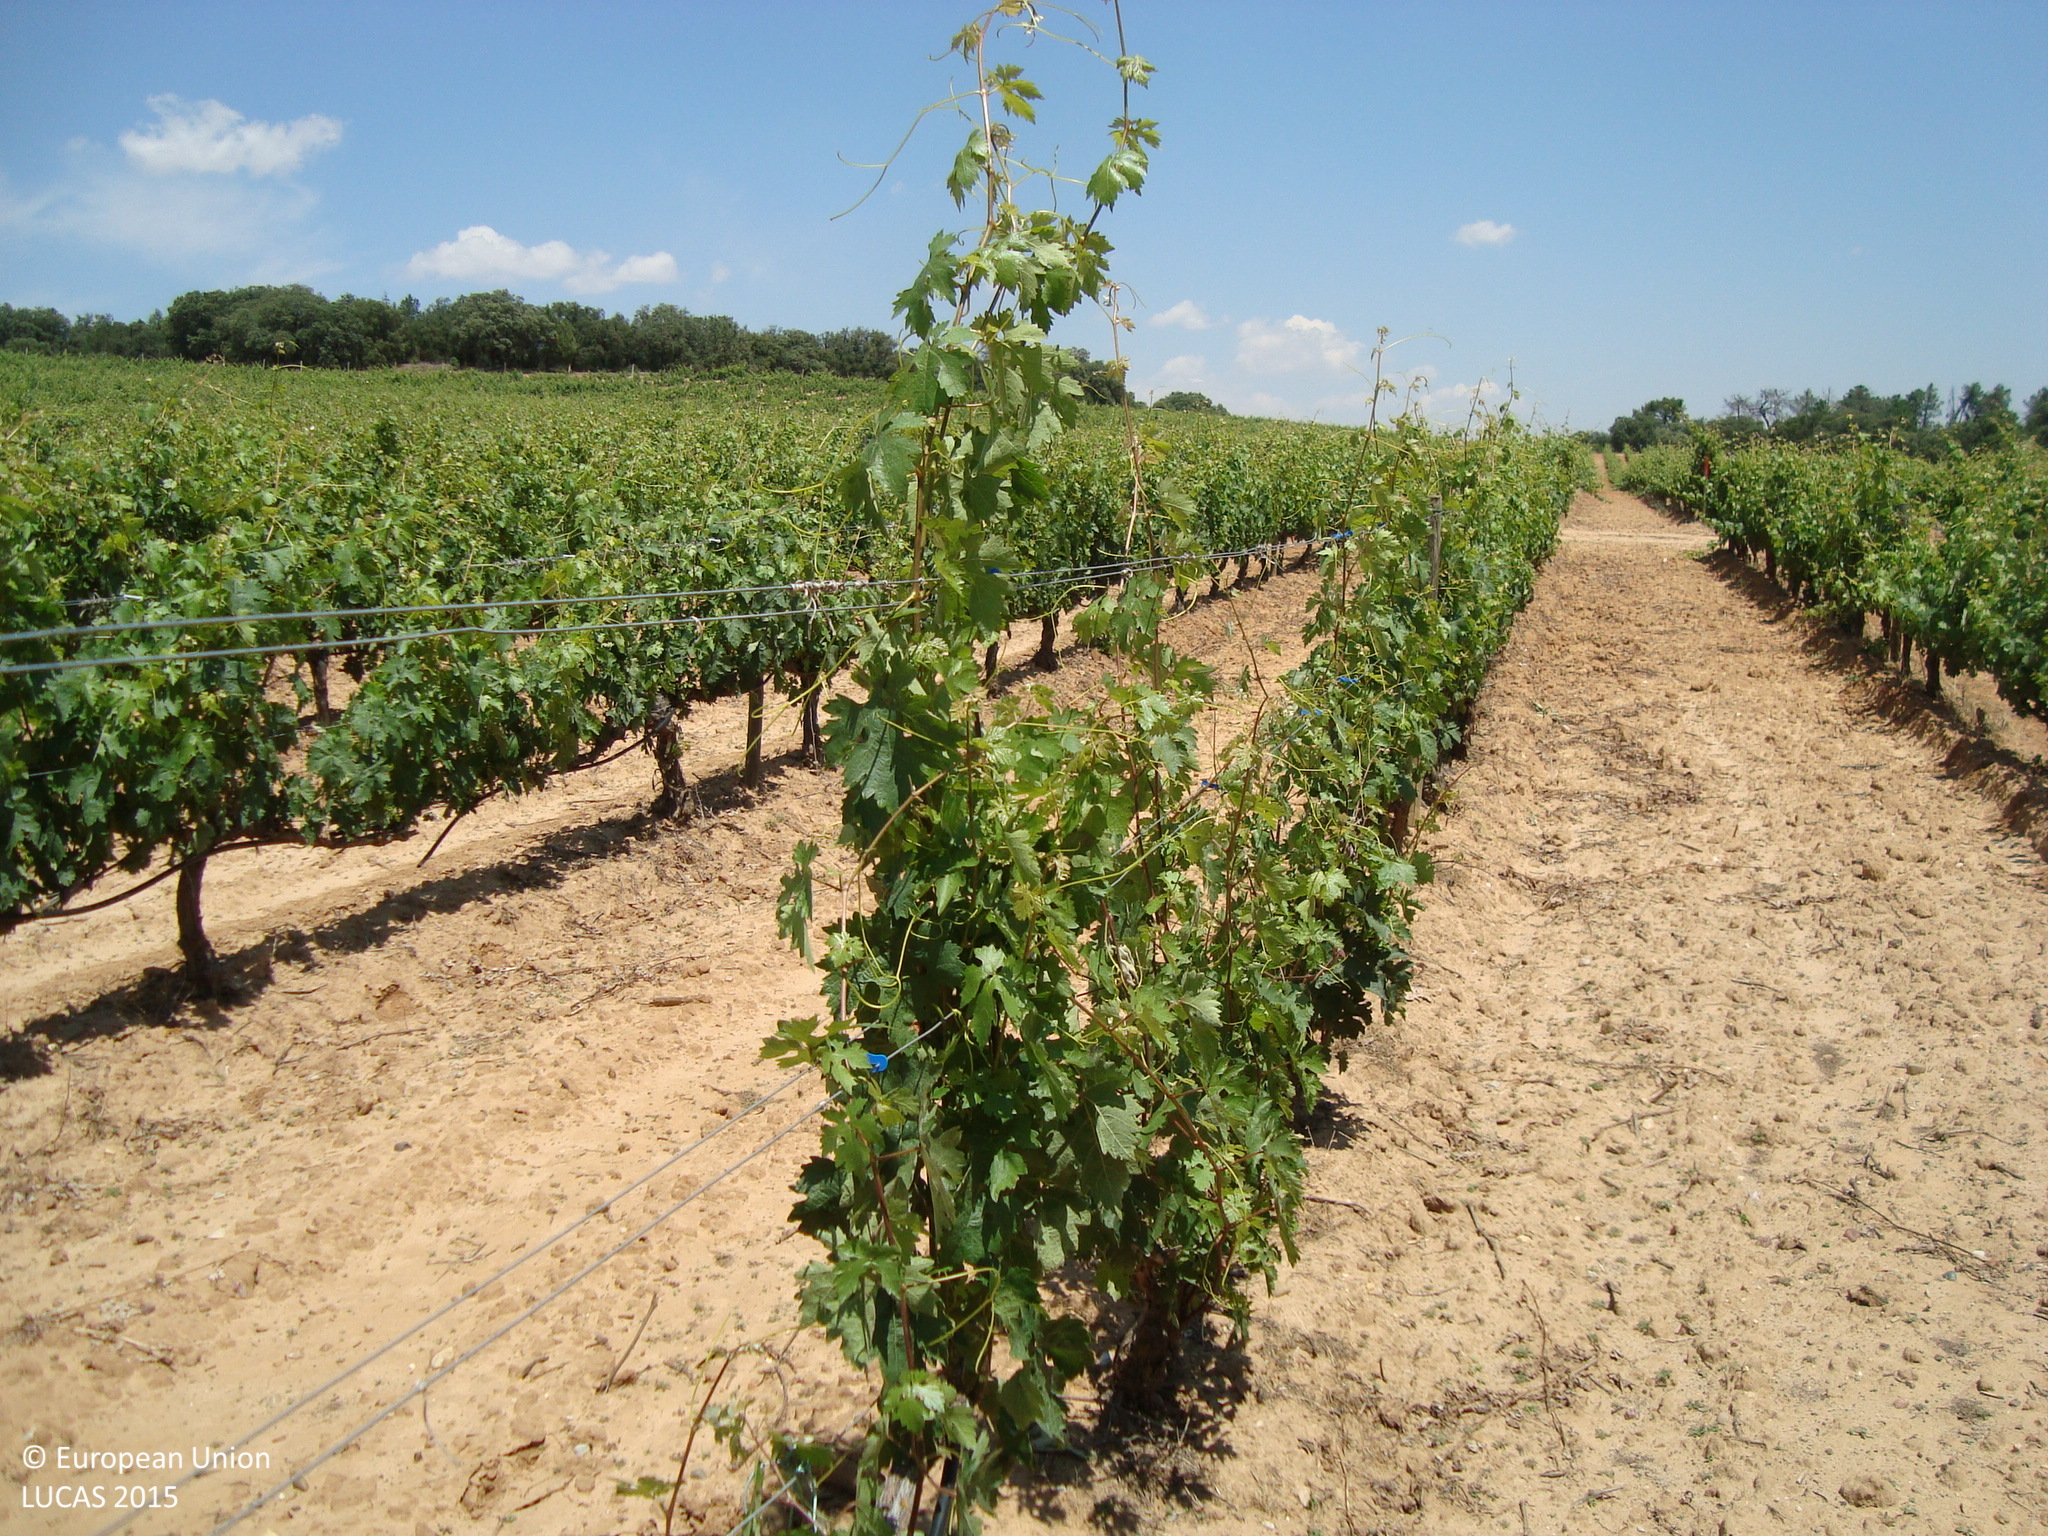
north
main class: Cropland
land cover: Vineyards
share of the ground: 25 - 50 %
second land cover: Other bare soil
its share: > 75 %
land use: Agriculture (excluding fallow land and kitchen gardens)
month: June
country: ES
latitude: 41.6879
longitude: -3.7867
